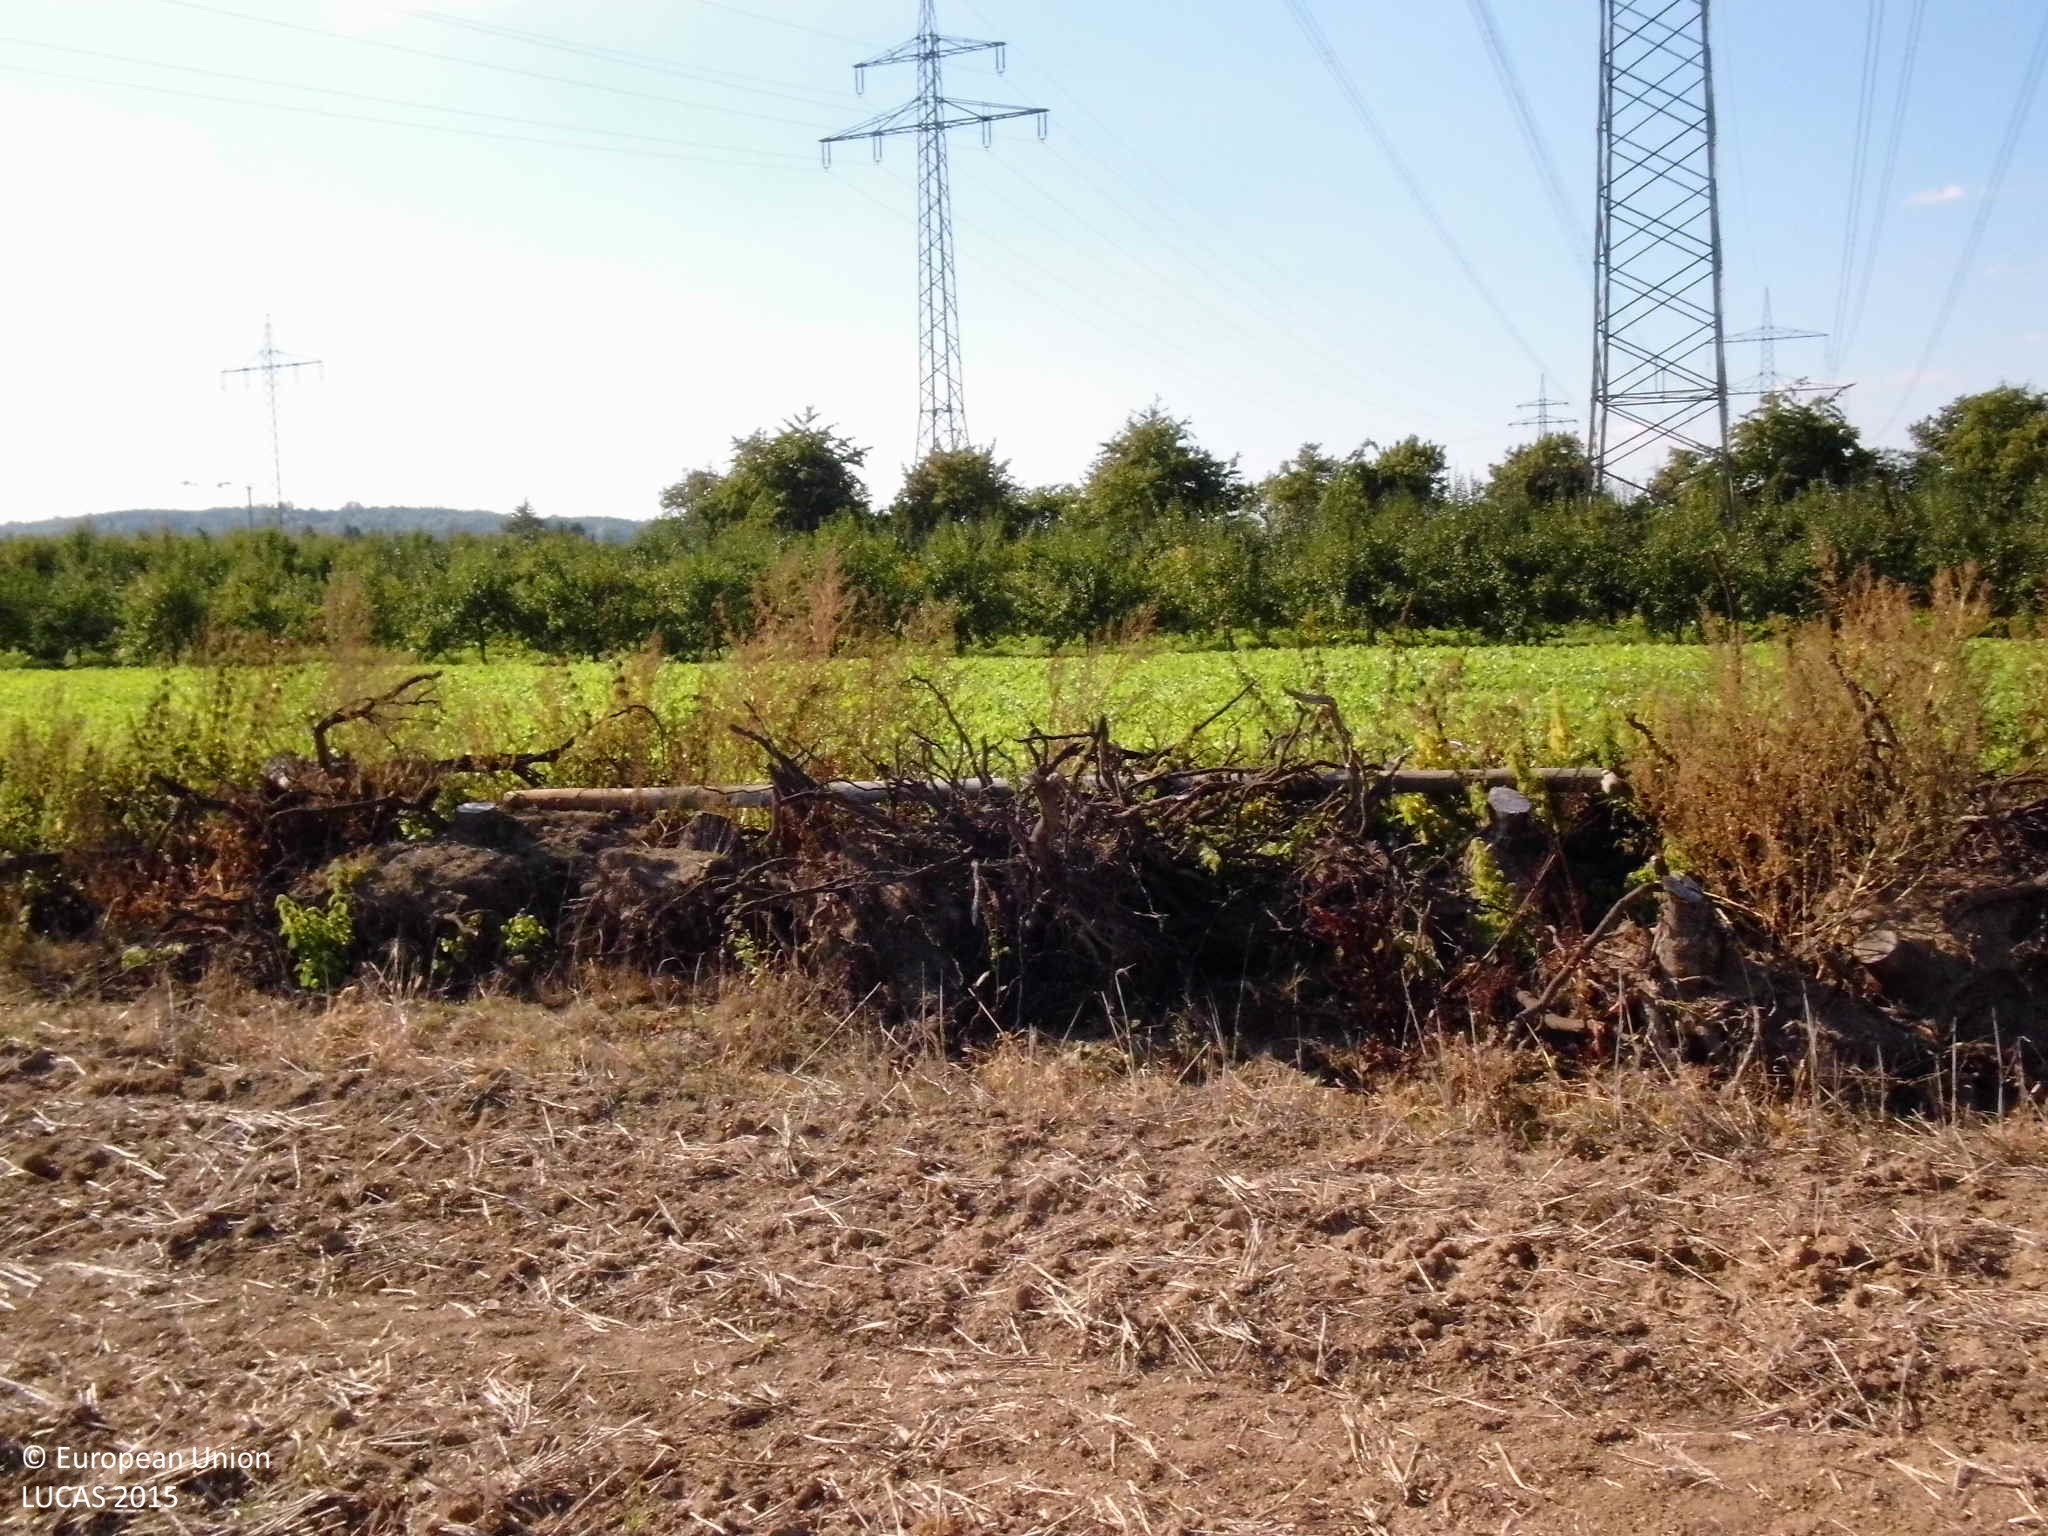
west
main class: Artificial land
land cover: Other artificial areas
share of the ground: < 10 %
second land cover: Common wheat
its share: < 10 %
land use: Electricity, gas and thermal power distribution
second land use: Agriculture (excluding fallow land and kitchen gardens)
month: September
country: DE
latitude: 50.3910
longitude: 7.5106
